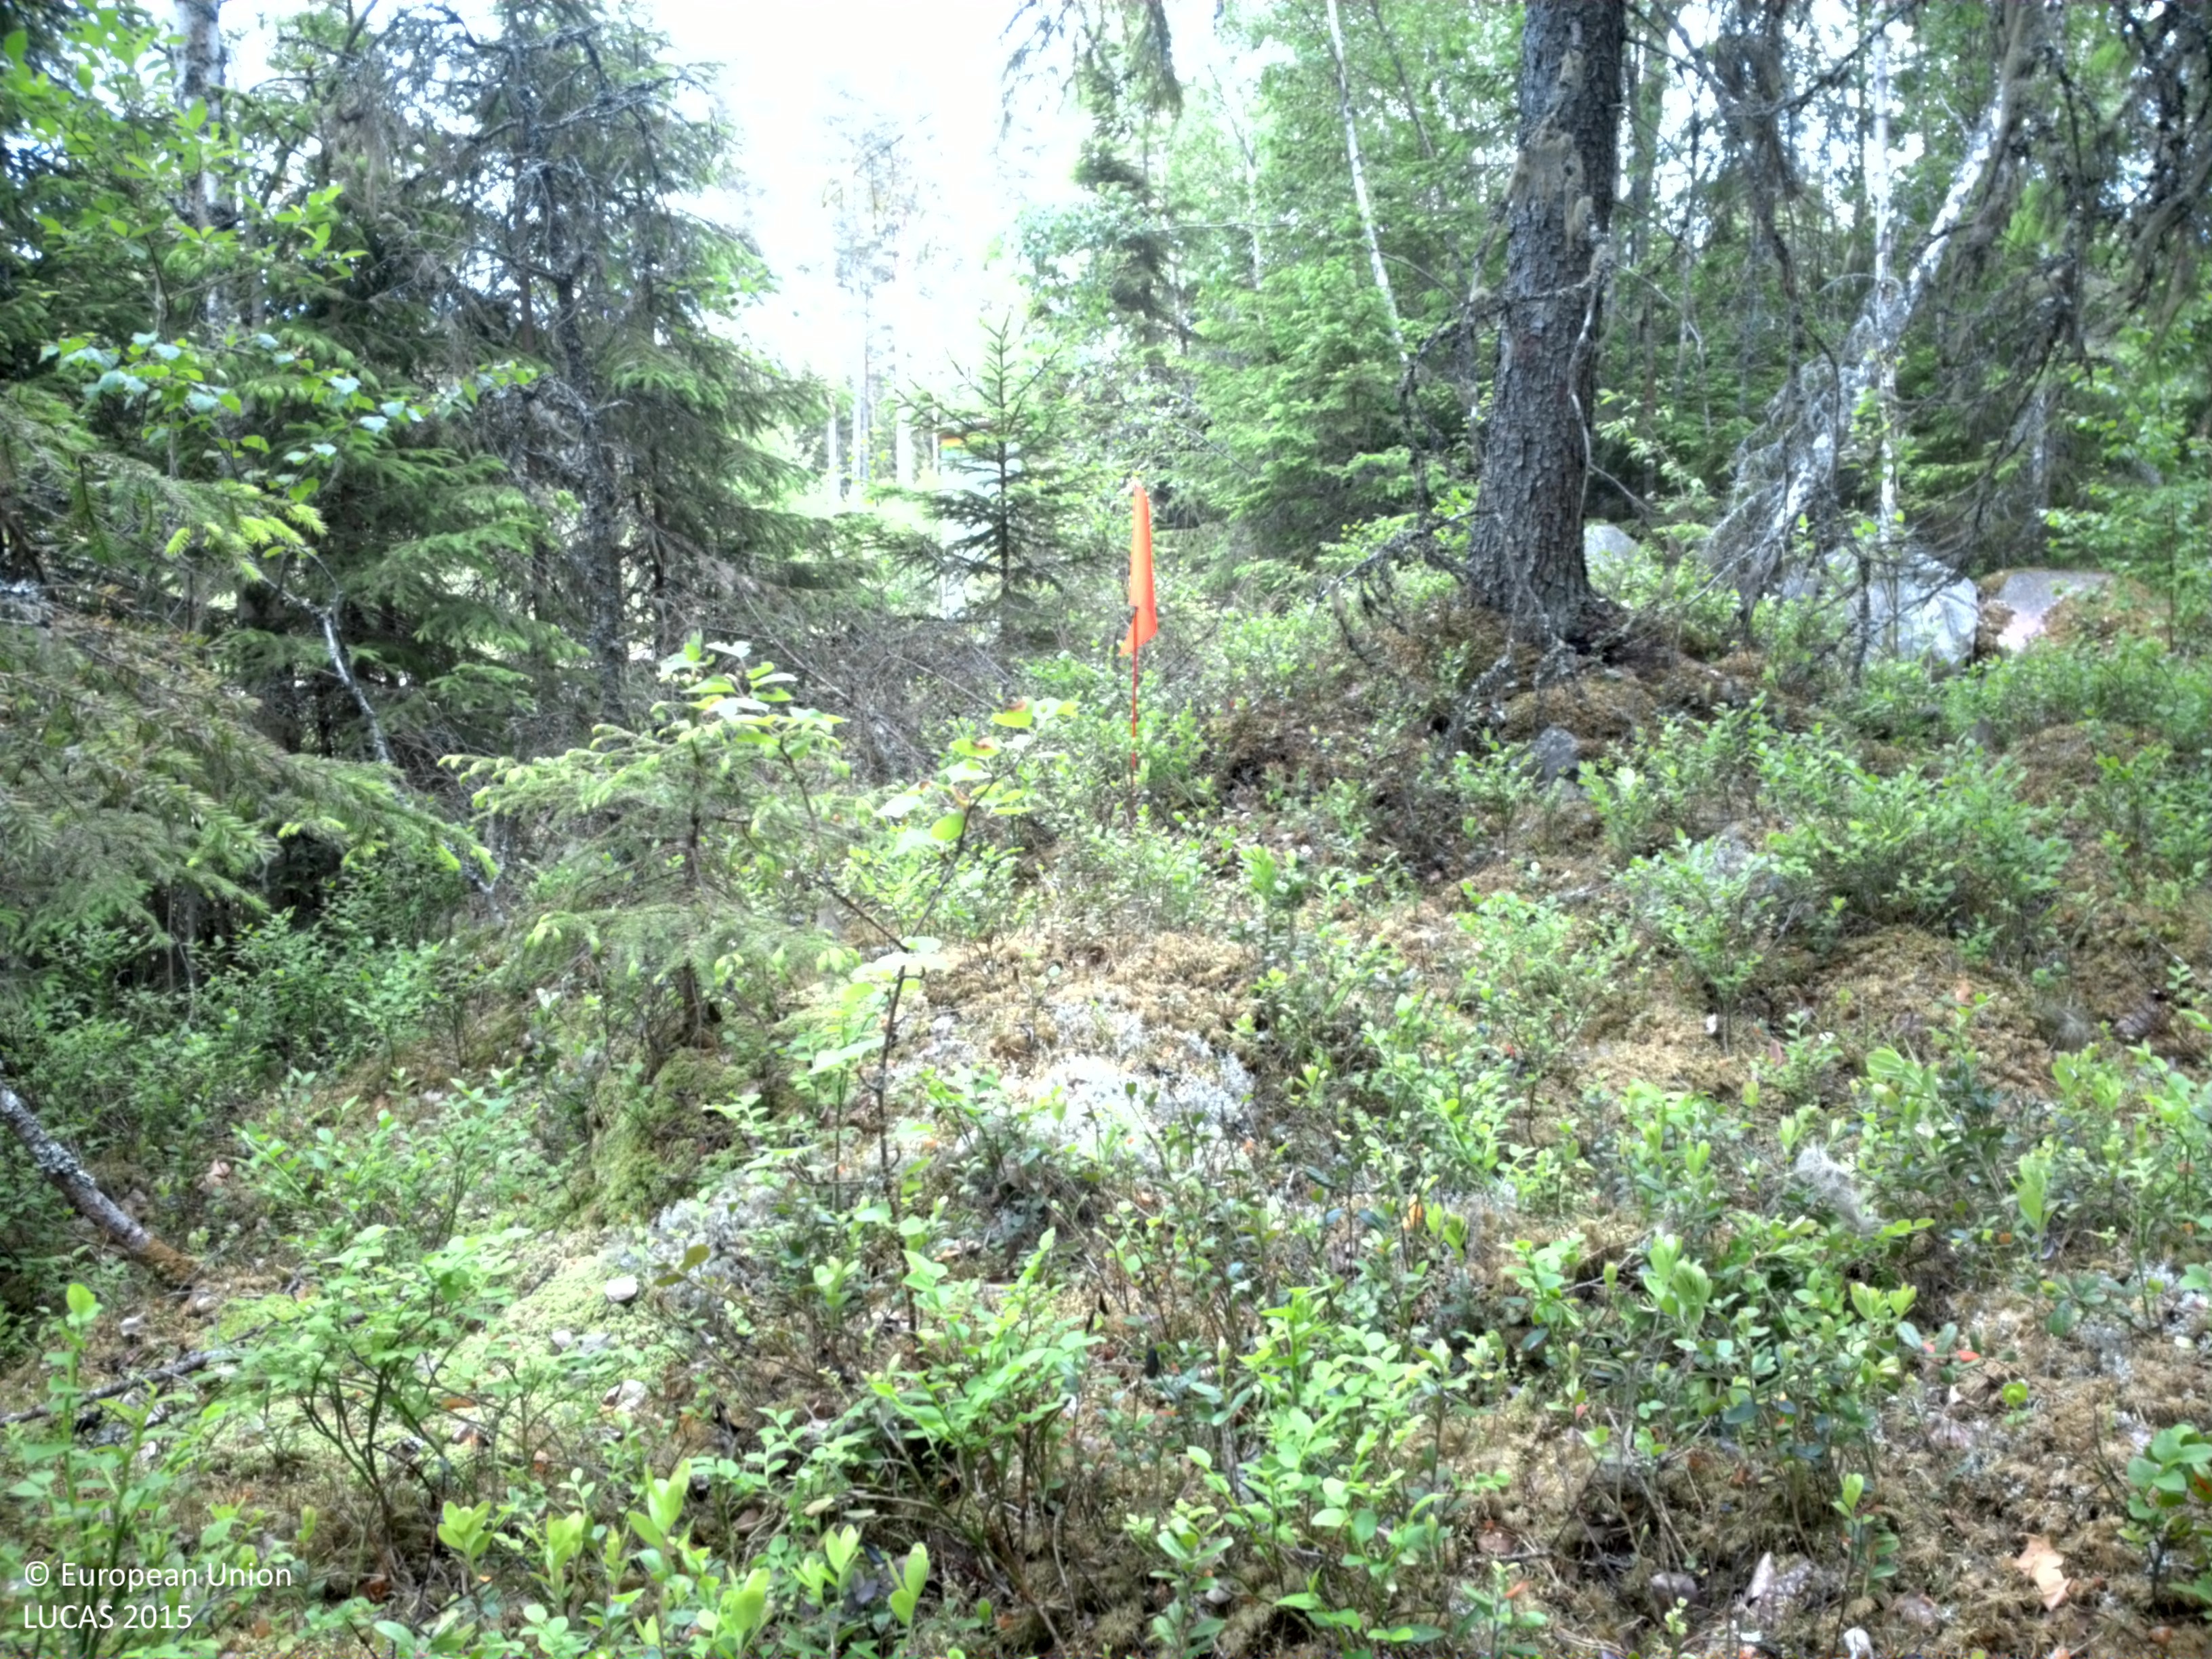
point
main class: Woodland
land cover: Spruce dominated coniferous woodland
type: boreal forest
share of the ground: 25 - 50 %
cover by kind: coniferous forest trees 45 %, herbaceous plants 25 %, lichens and mosses 25 %, broadleaved forest trees 5 %
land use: Forestry
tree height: > 5 m
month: June
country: SE
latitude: 60.0298
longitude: 17.2605
